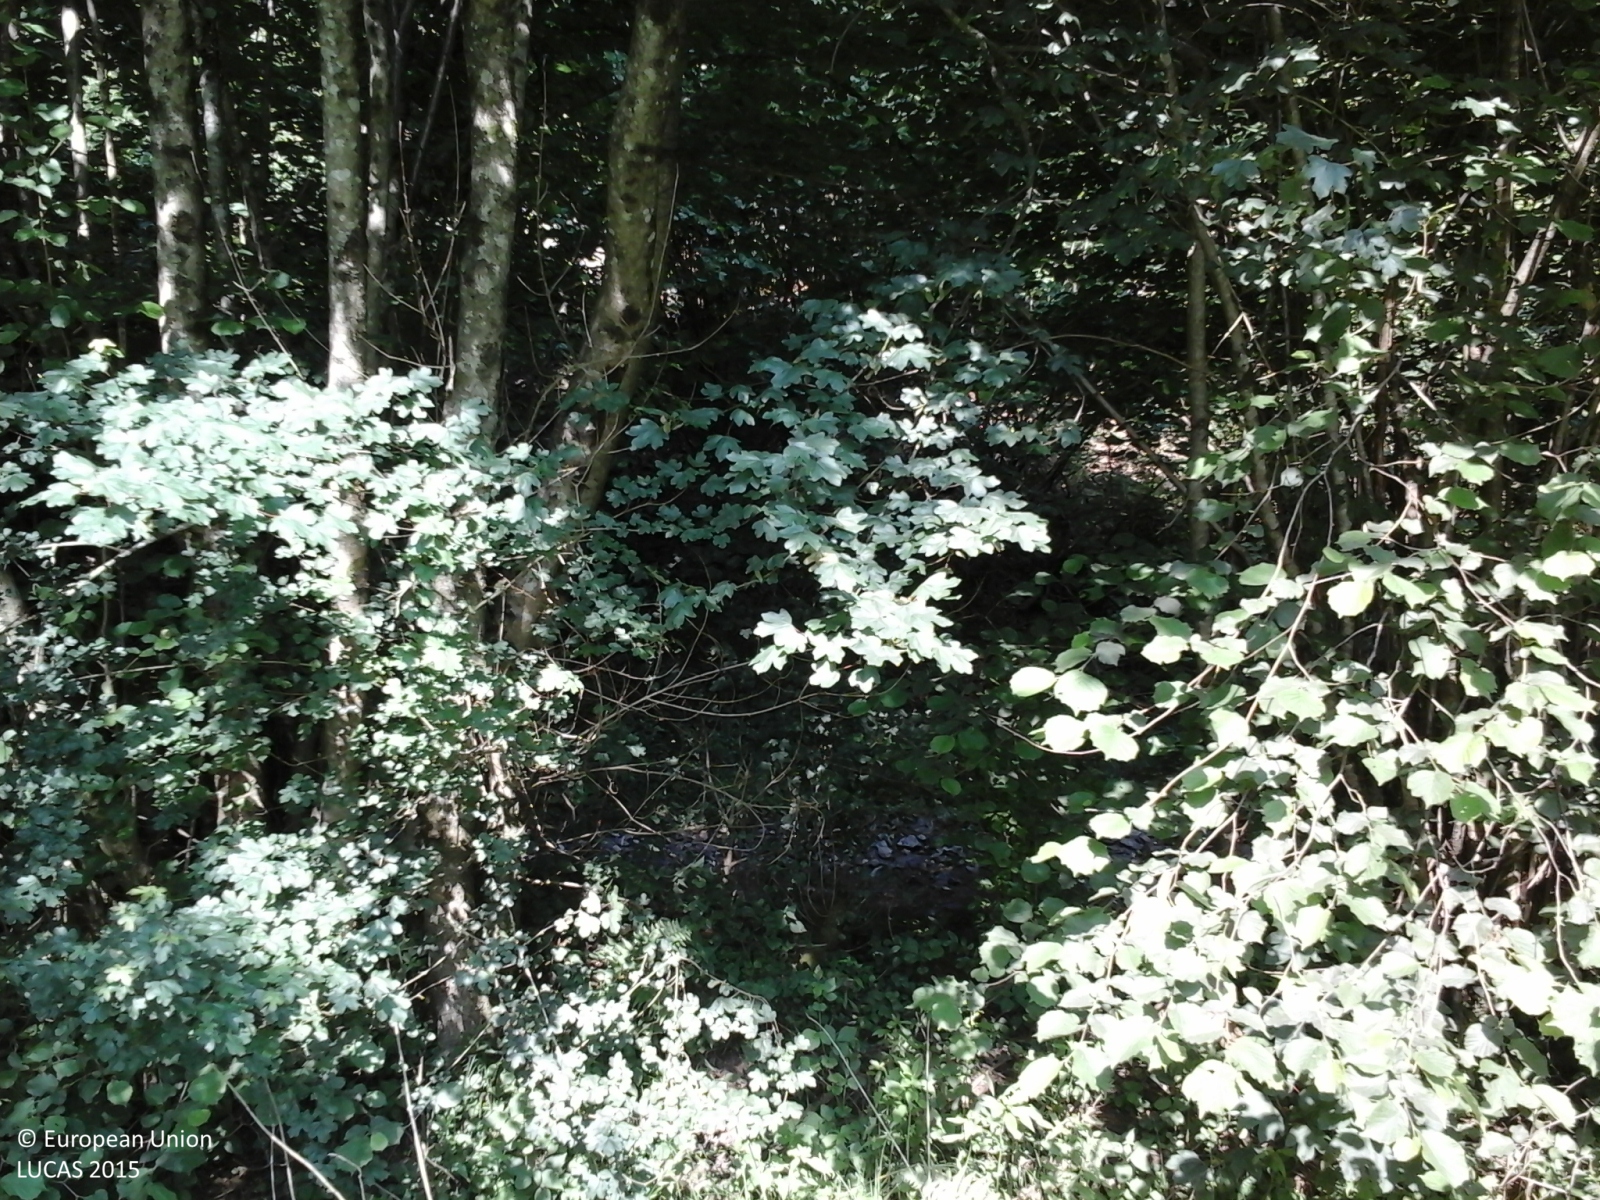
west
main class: Grassland
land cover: Grassland without tree/shrub cover
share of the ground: > 75 %
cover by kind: herbaceous plants 100 %
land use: Agriculture (excluding fallow land and kitchen gardens)
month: June
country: IT
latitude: 45.8162
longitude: 8.3680
